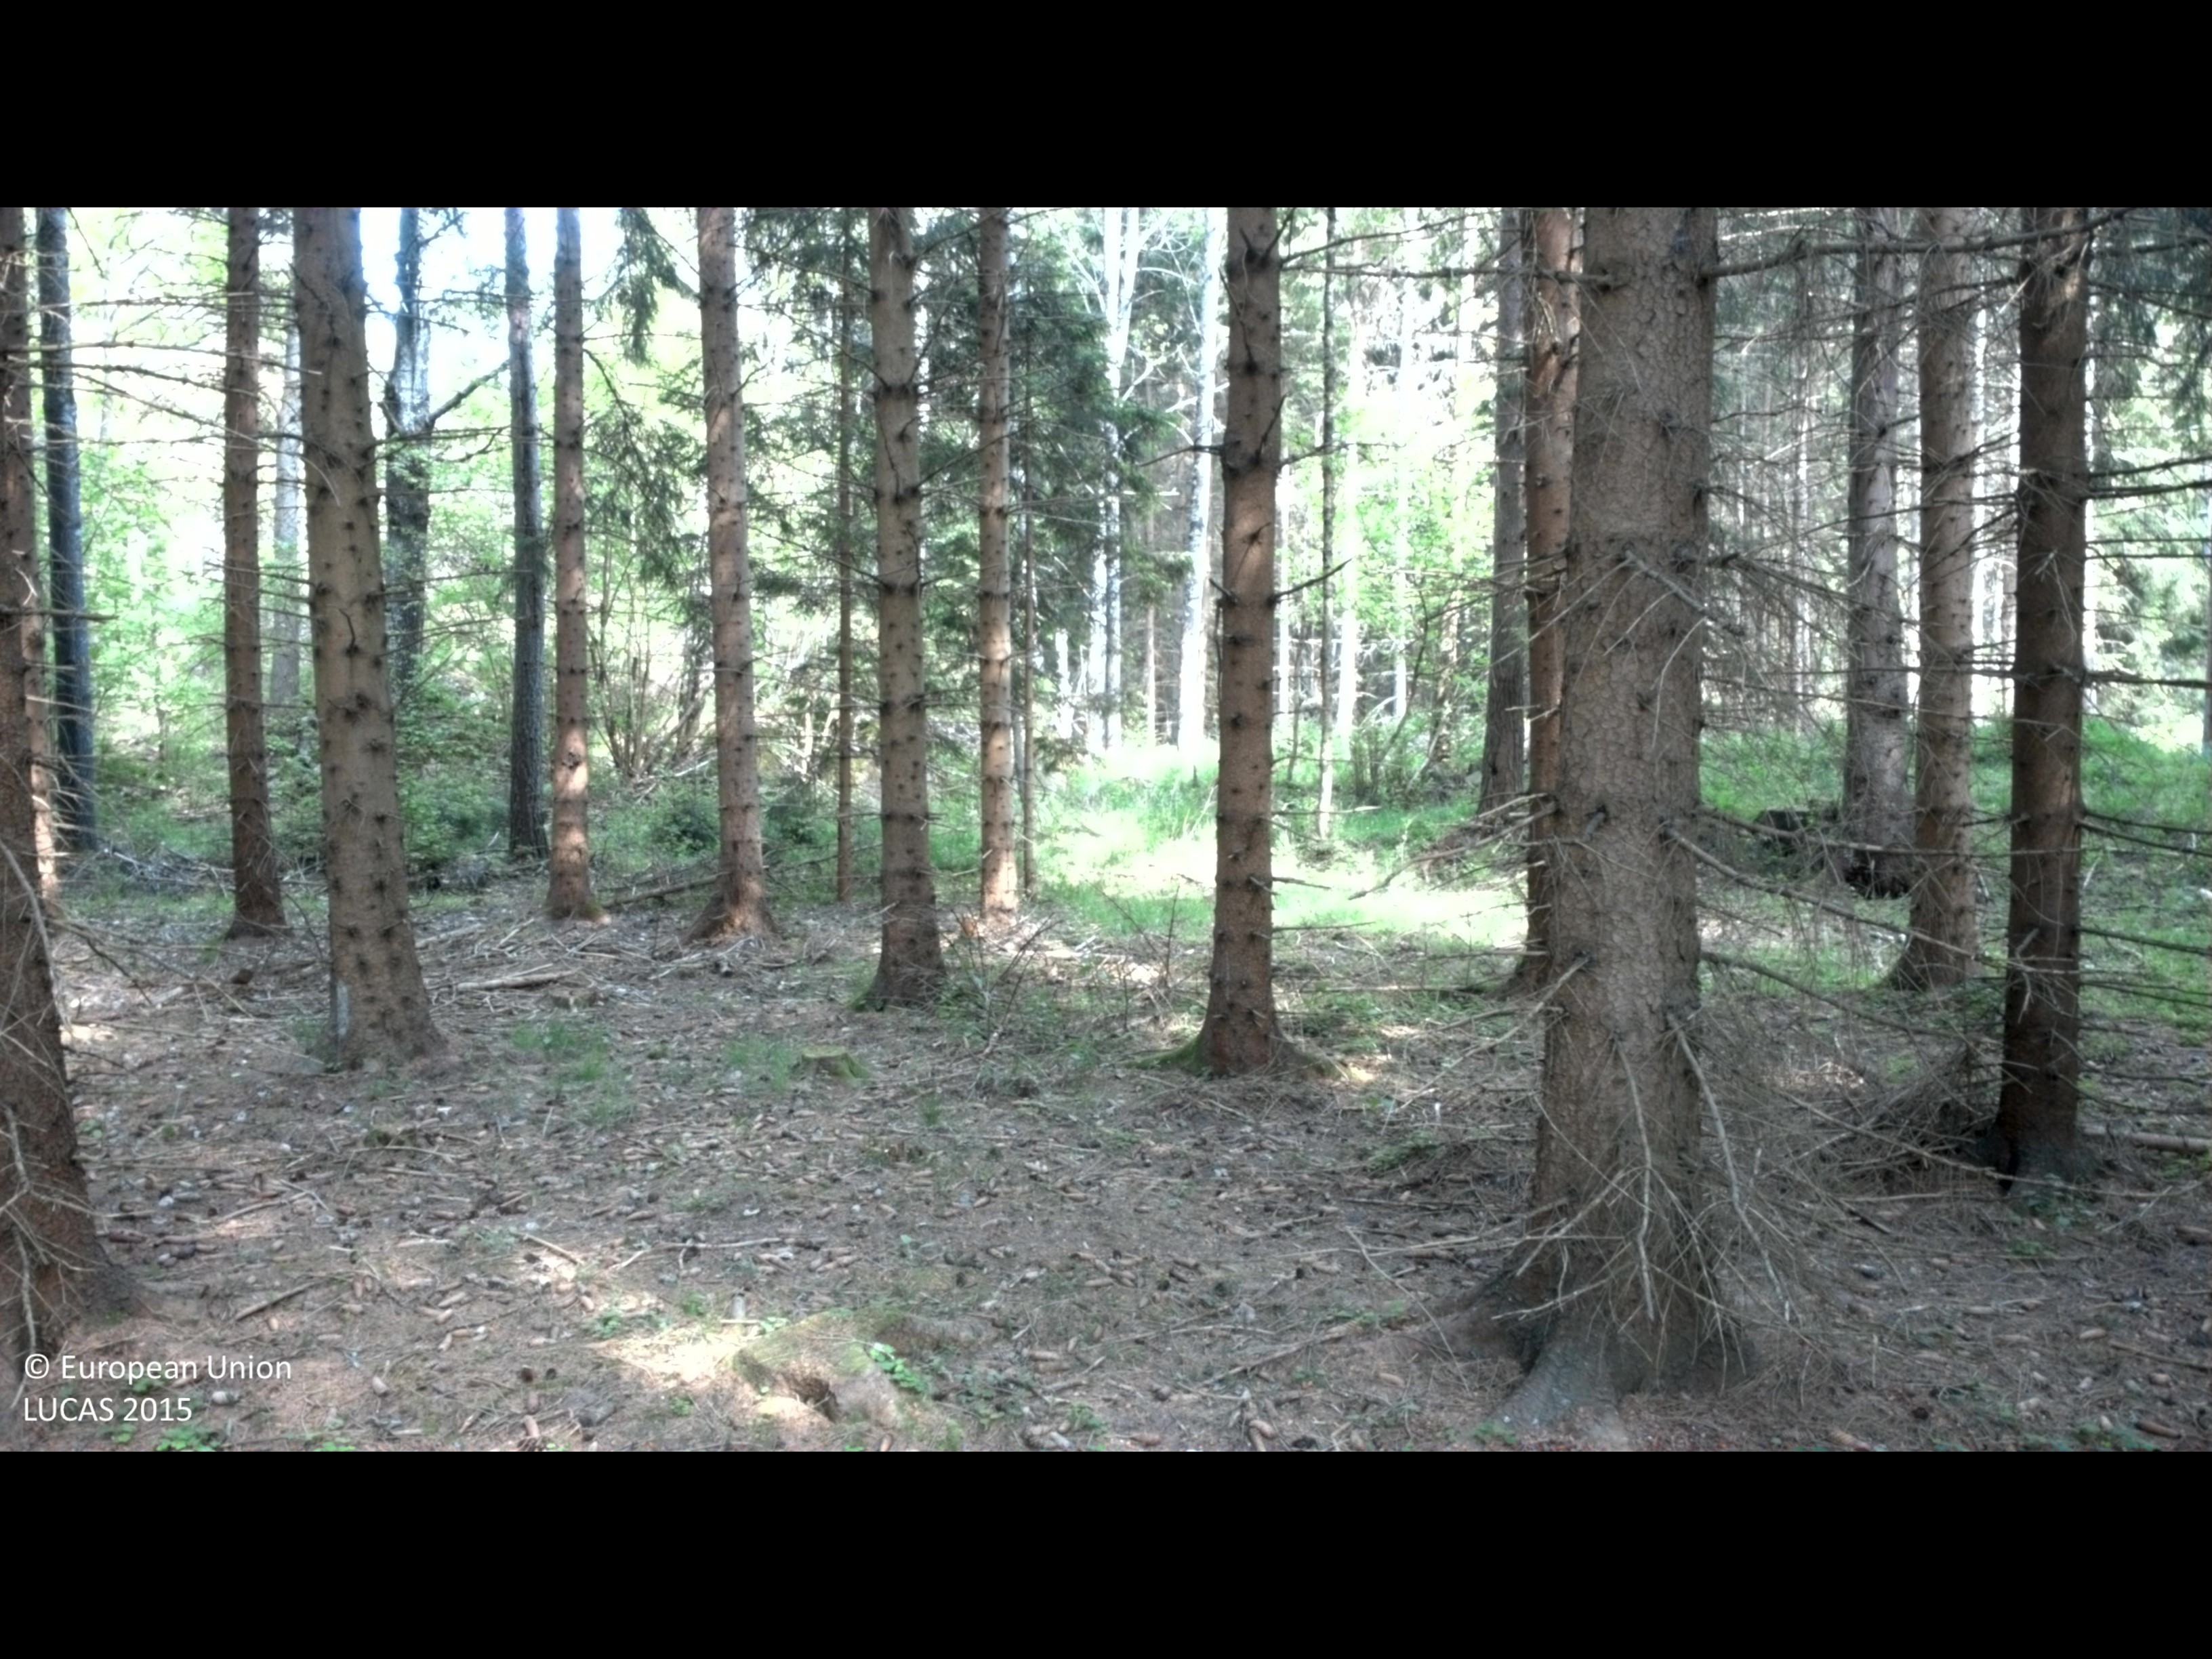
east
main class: Woodland
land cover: Spruce dominated coniferous woodland
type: boreal forest
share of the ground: > 75 %
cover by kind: coniferous forest trees 95 %, herbaceous plants 5 %
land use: Forestry
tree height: > 5 m
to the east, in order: Spruce dominated coniferous woodland; Ditches and canals; Spruce dominated coniferous woodland; Broadleaved woodland; Spruce dominated coniferous woodland; Ditches and canals; Spruce dominated coniferous woodland; Broadleaved woodland; Pine dominated coniferous woodland
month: May
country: SE
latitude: 57.4087
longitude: 16.5747
